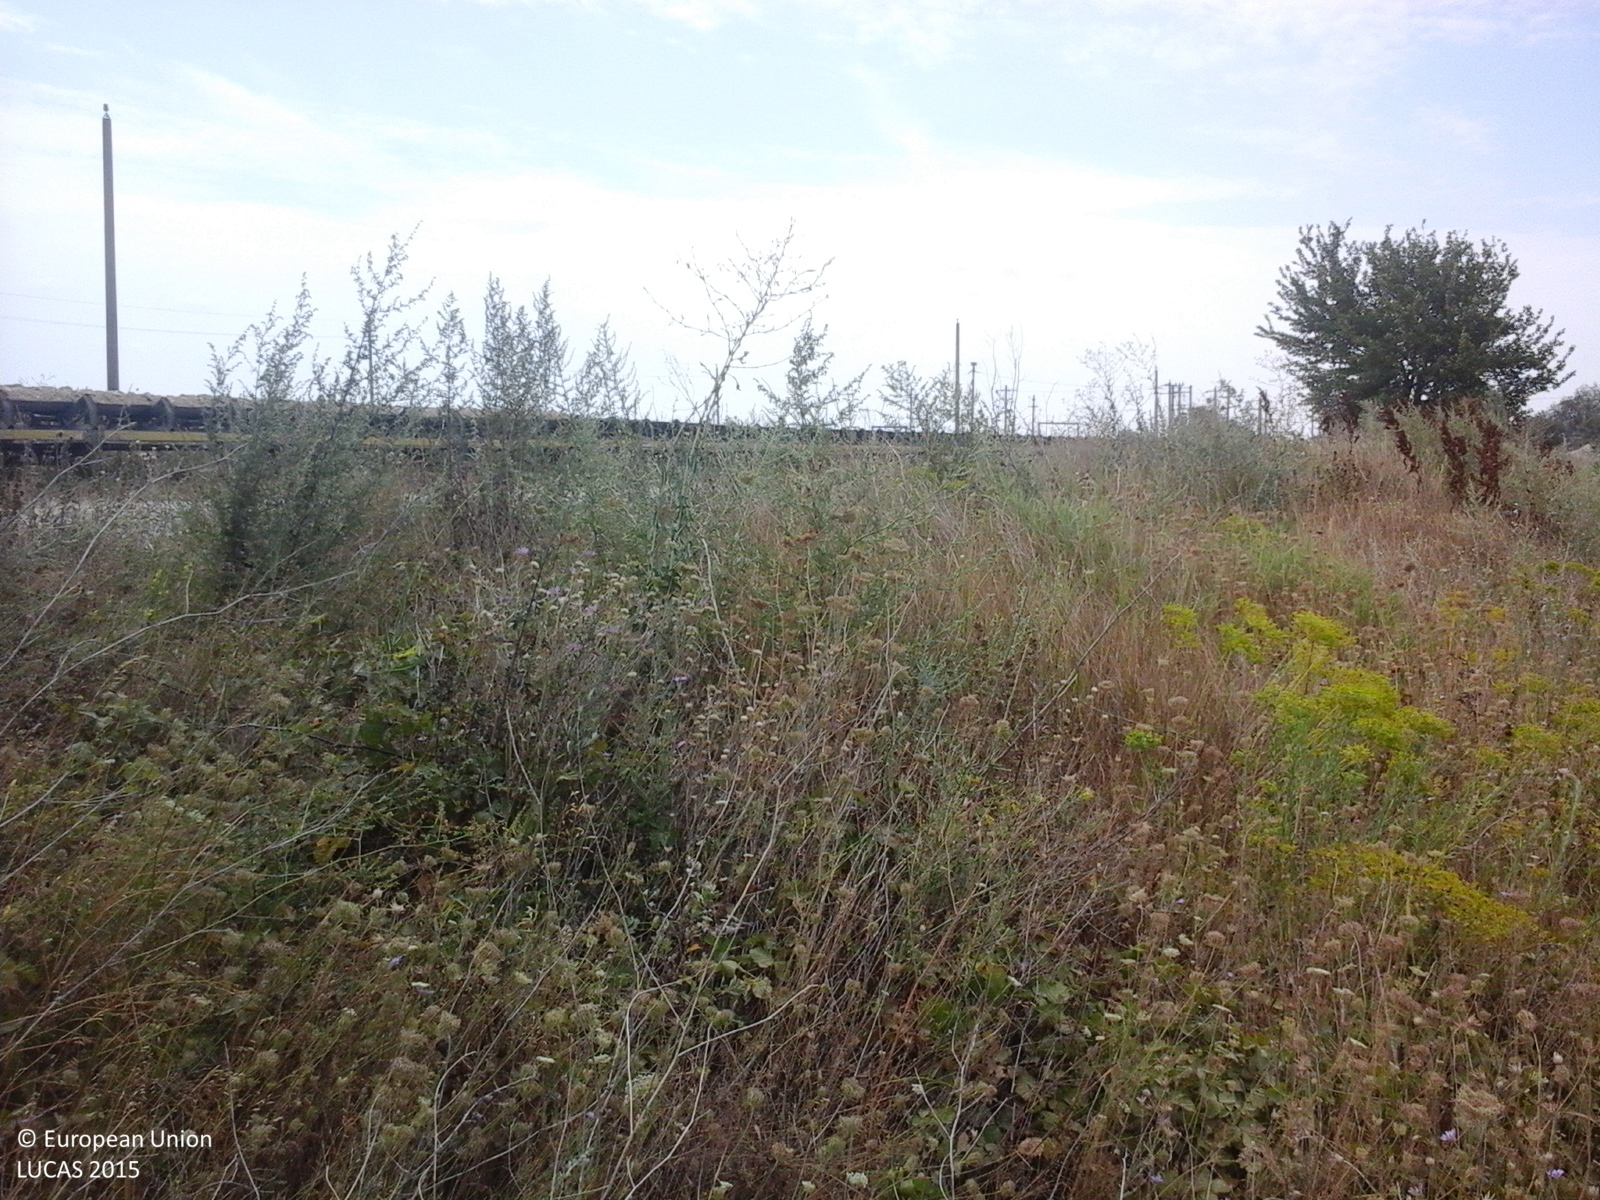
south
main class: Grassland
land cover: Spontaneously vegetated surfaces
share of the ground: > 75 %
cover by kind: herbaceous plants 100 %
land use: Fallow land
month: August
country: RO
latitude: 45.0733
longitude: 29.0886
